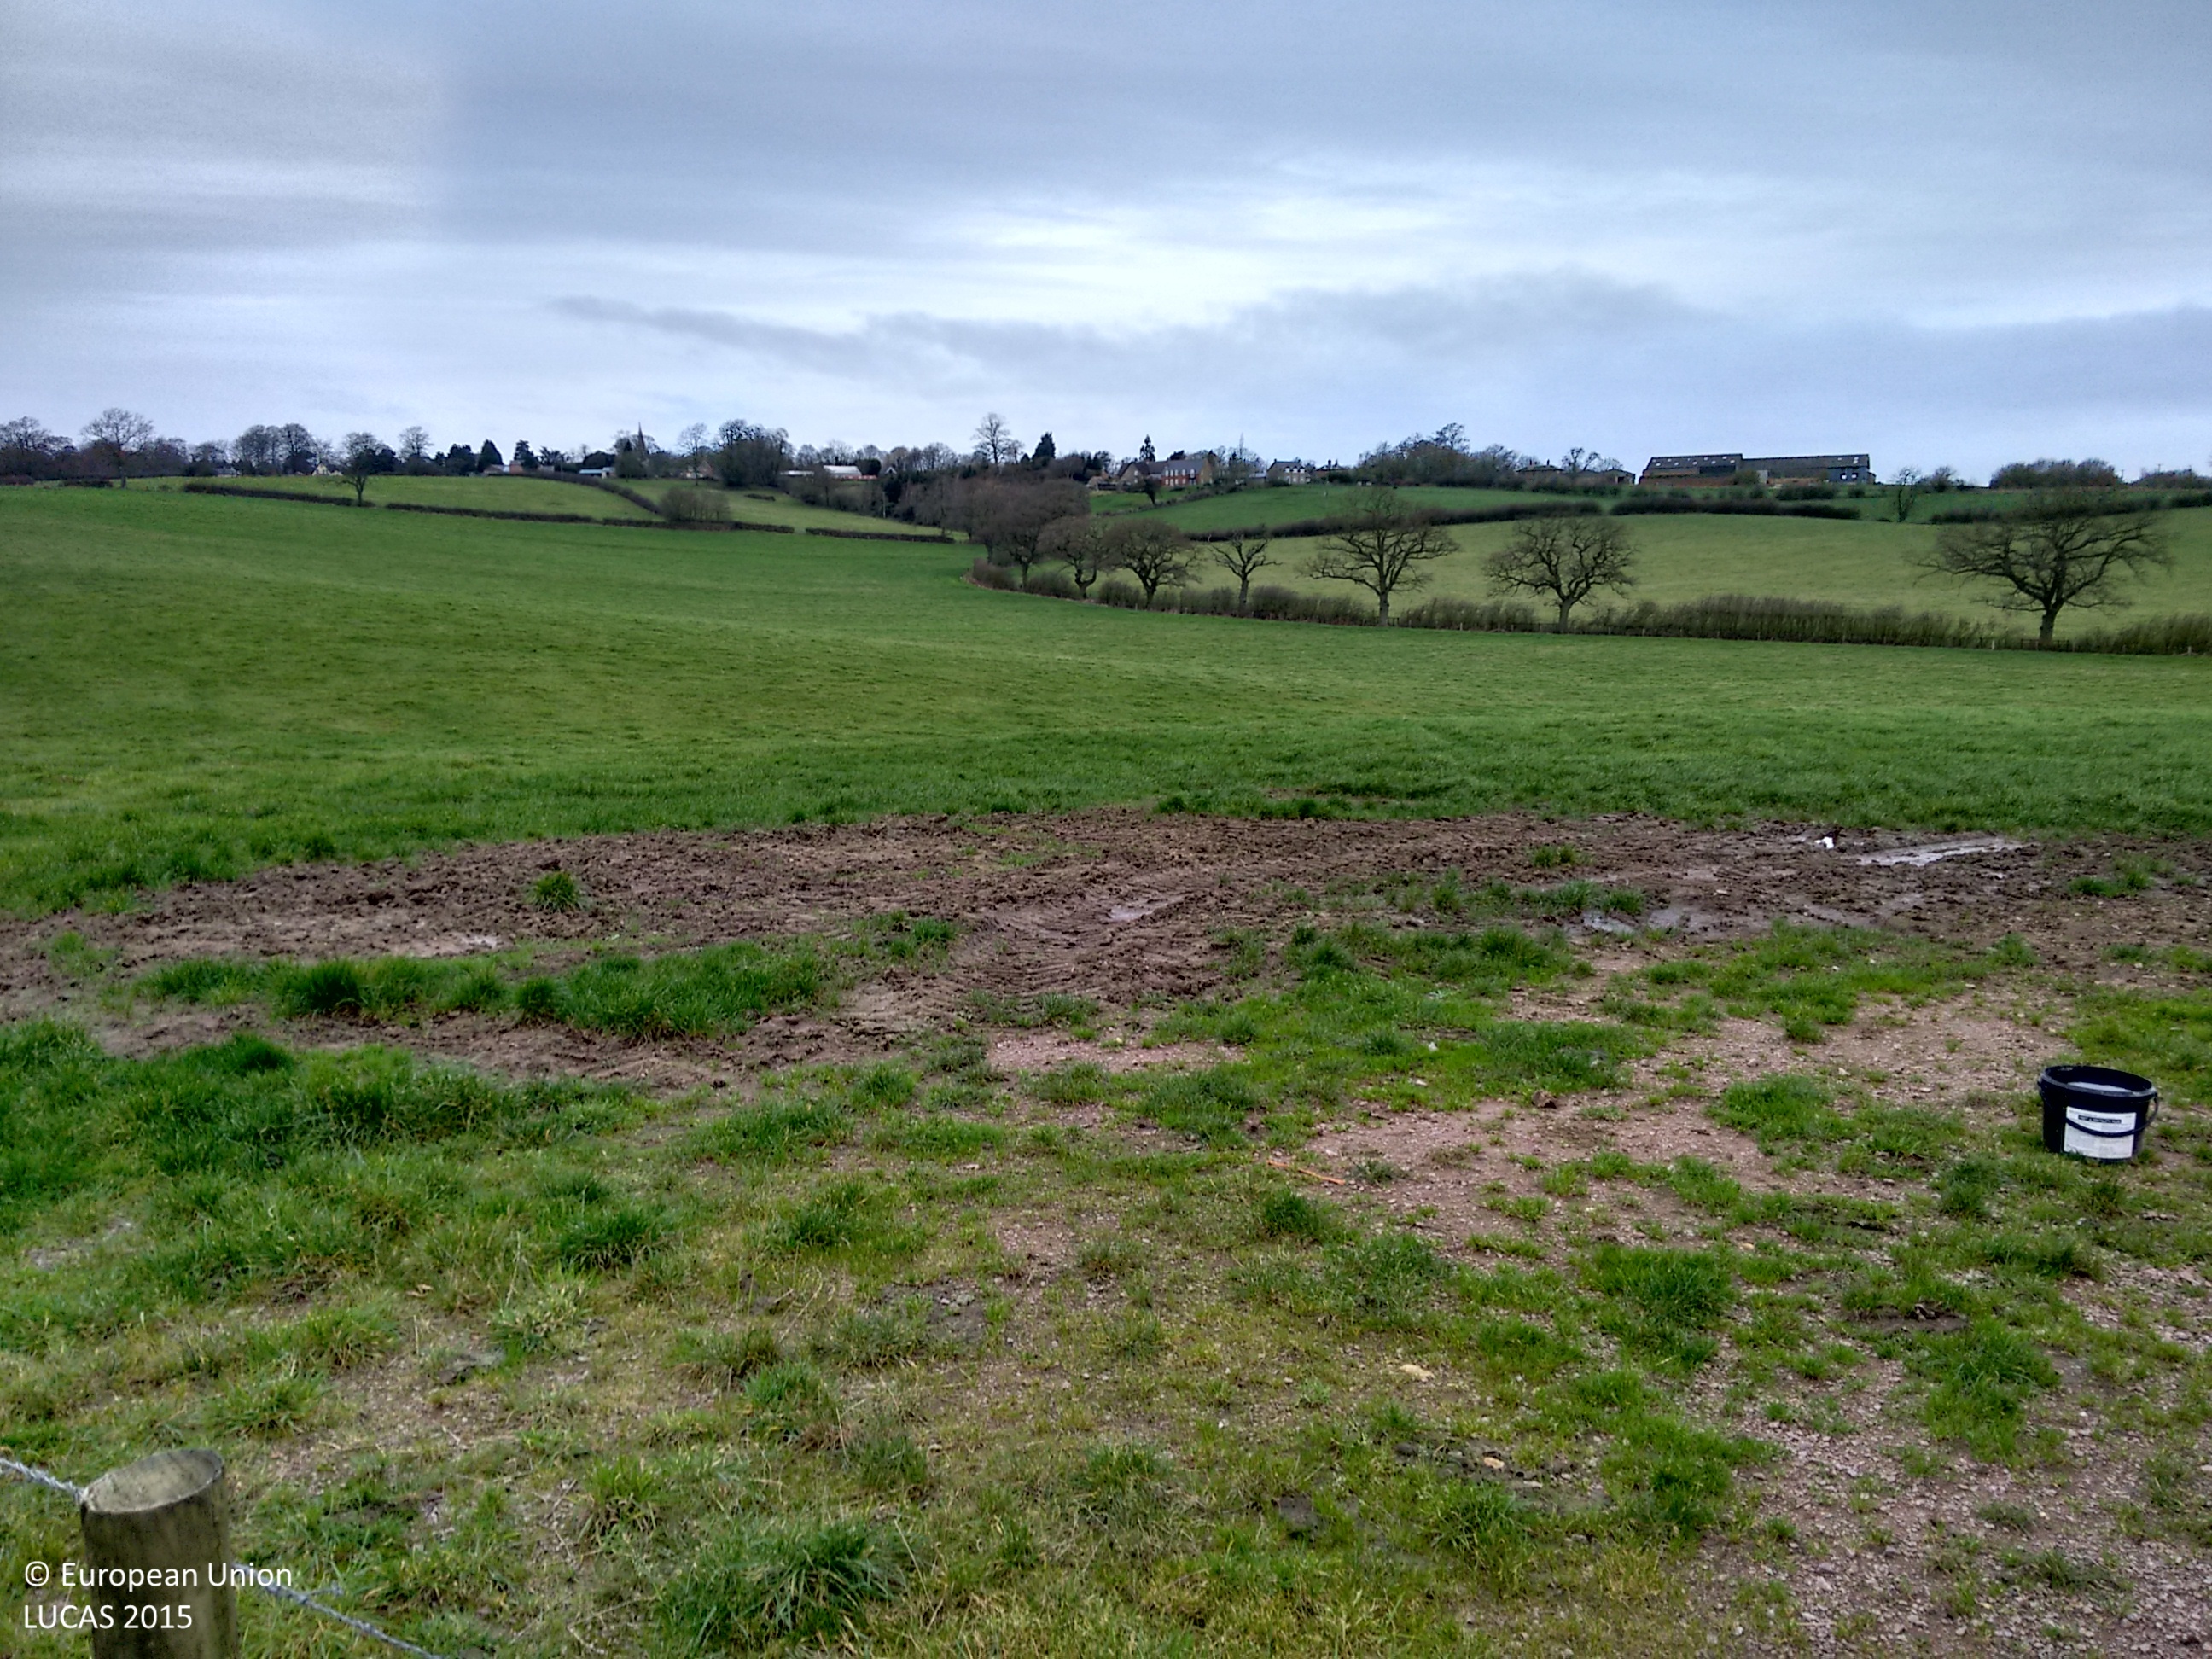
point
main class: Grassland
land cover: Grassland without tree/shrub cover
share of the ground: > 75 %
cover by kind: herbaceous plants 100 %
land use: Agriculture (excluding fallow land and kitchen gardens)
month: December
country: GB
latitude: 52.6820
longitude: -0.7953
